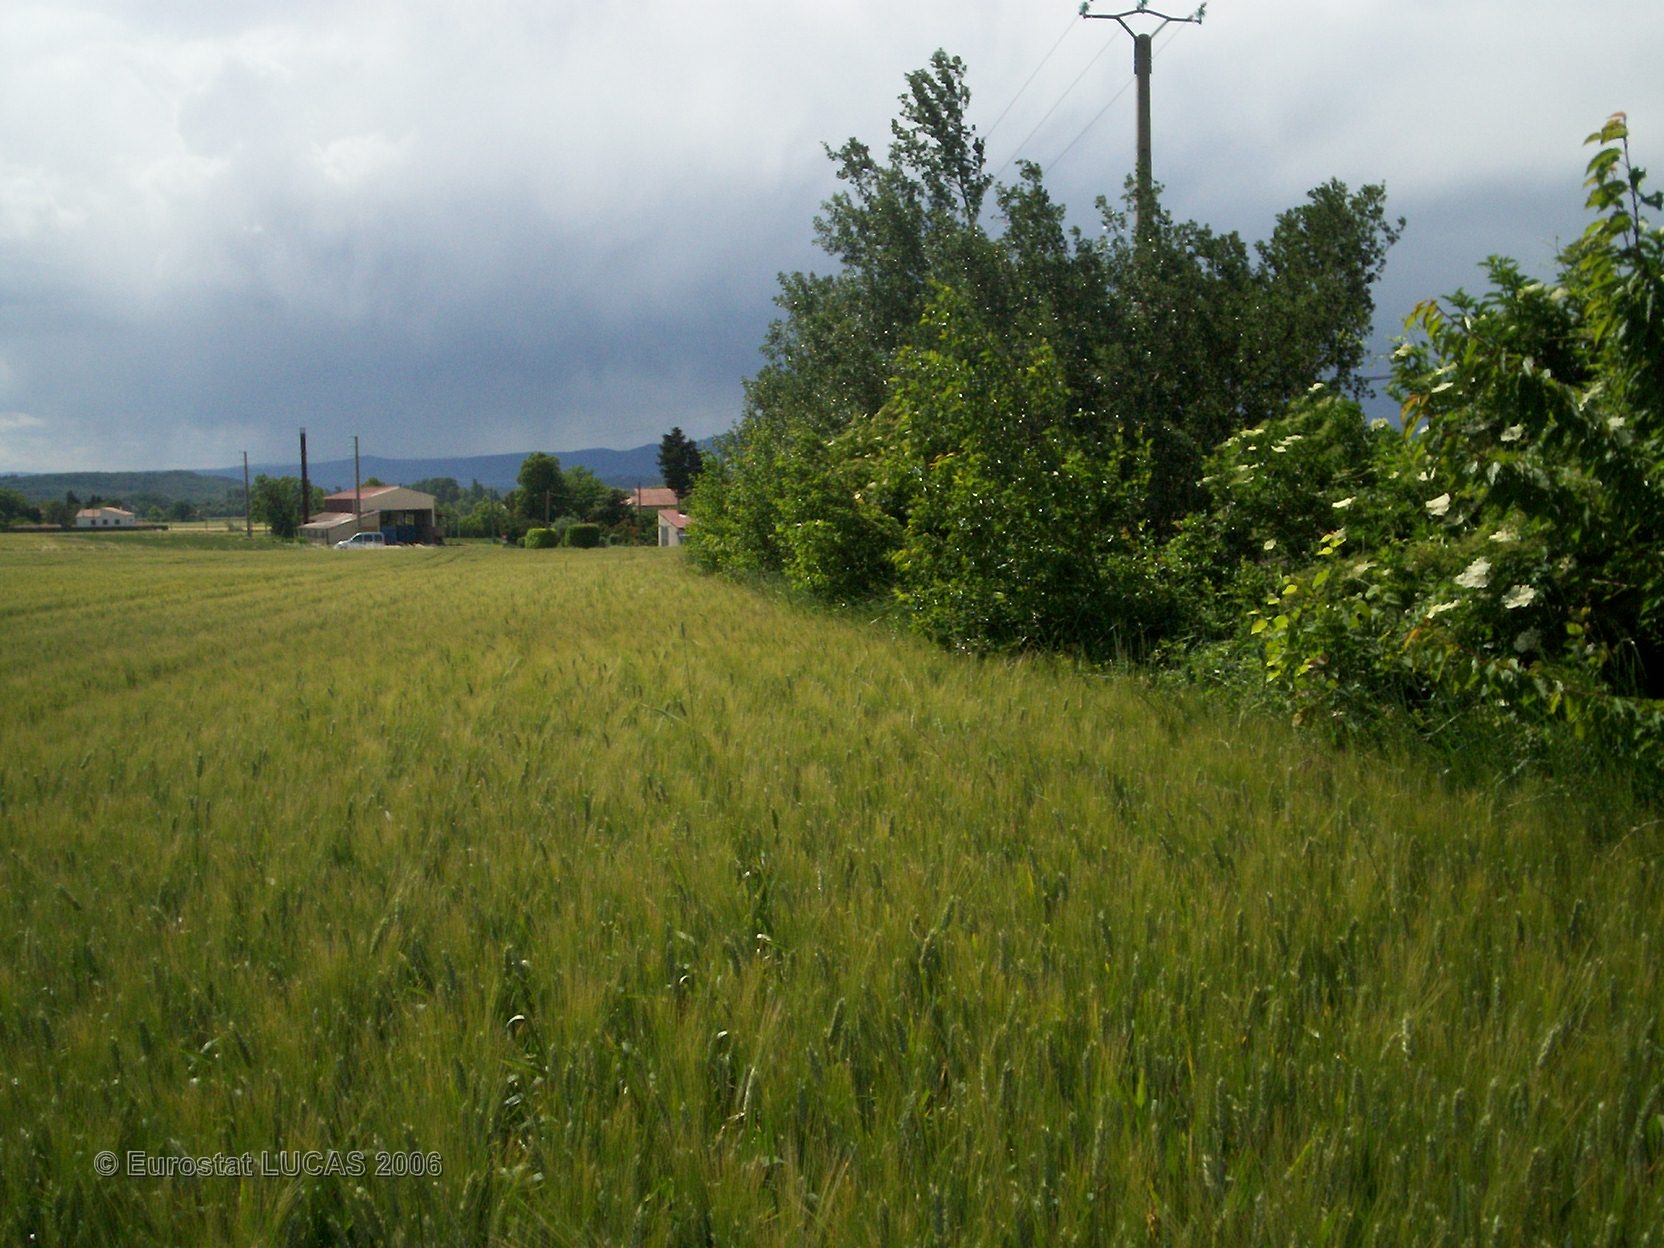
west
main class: Cropland
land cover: Durum wheat
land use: Agriculture (excluding fallow land and kitchen gardens)
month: May
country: FR
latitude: 44.5651
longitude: 4.8318
